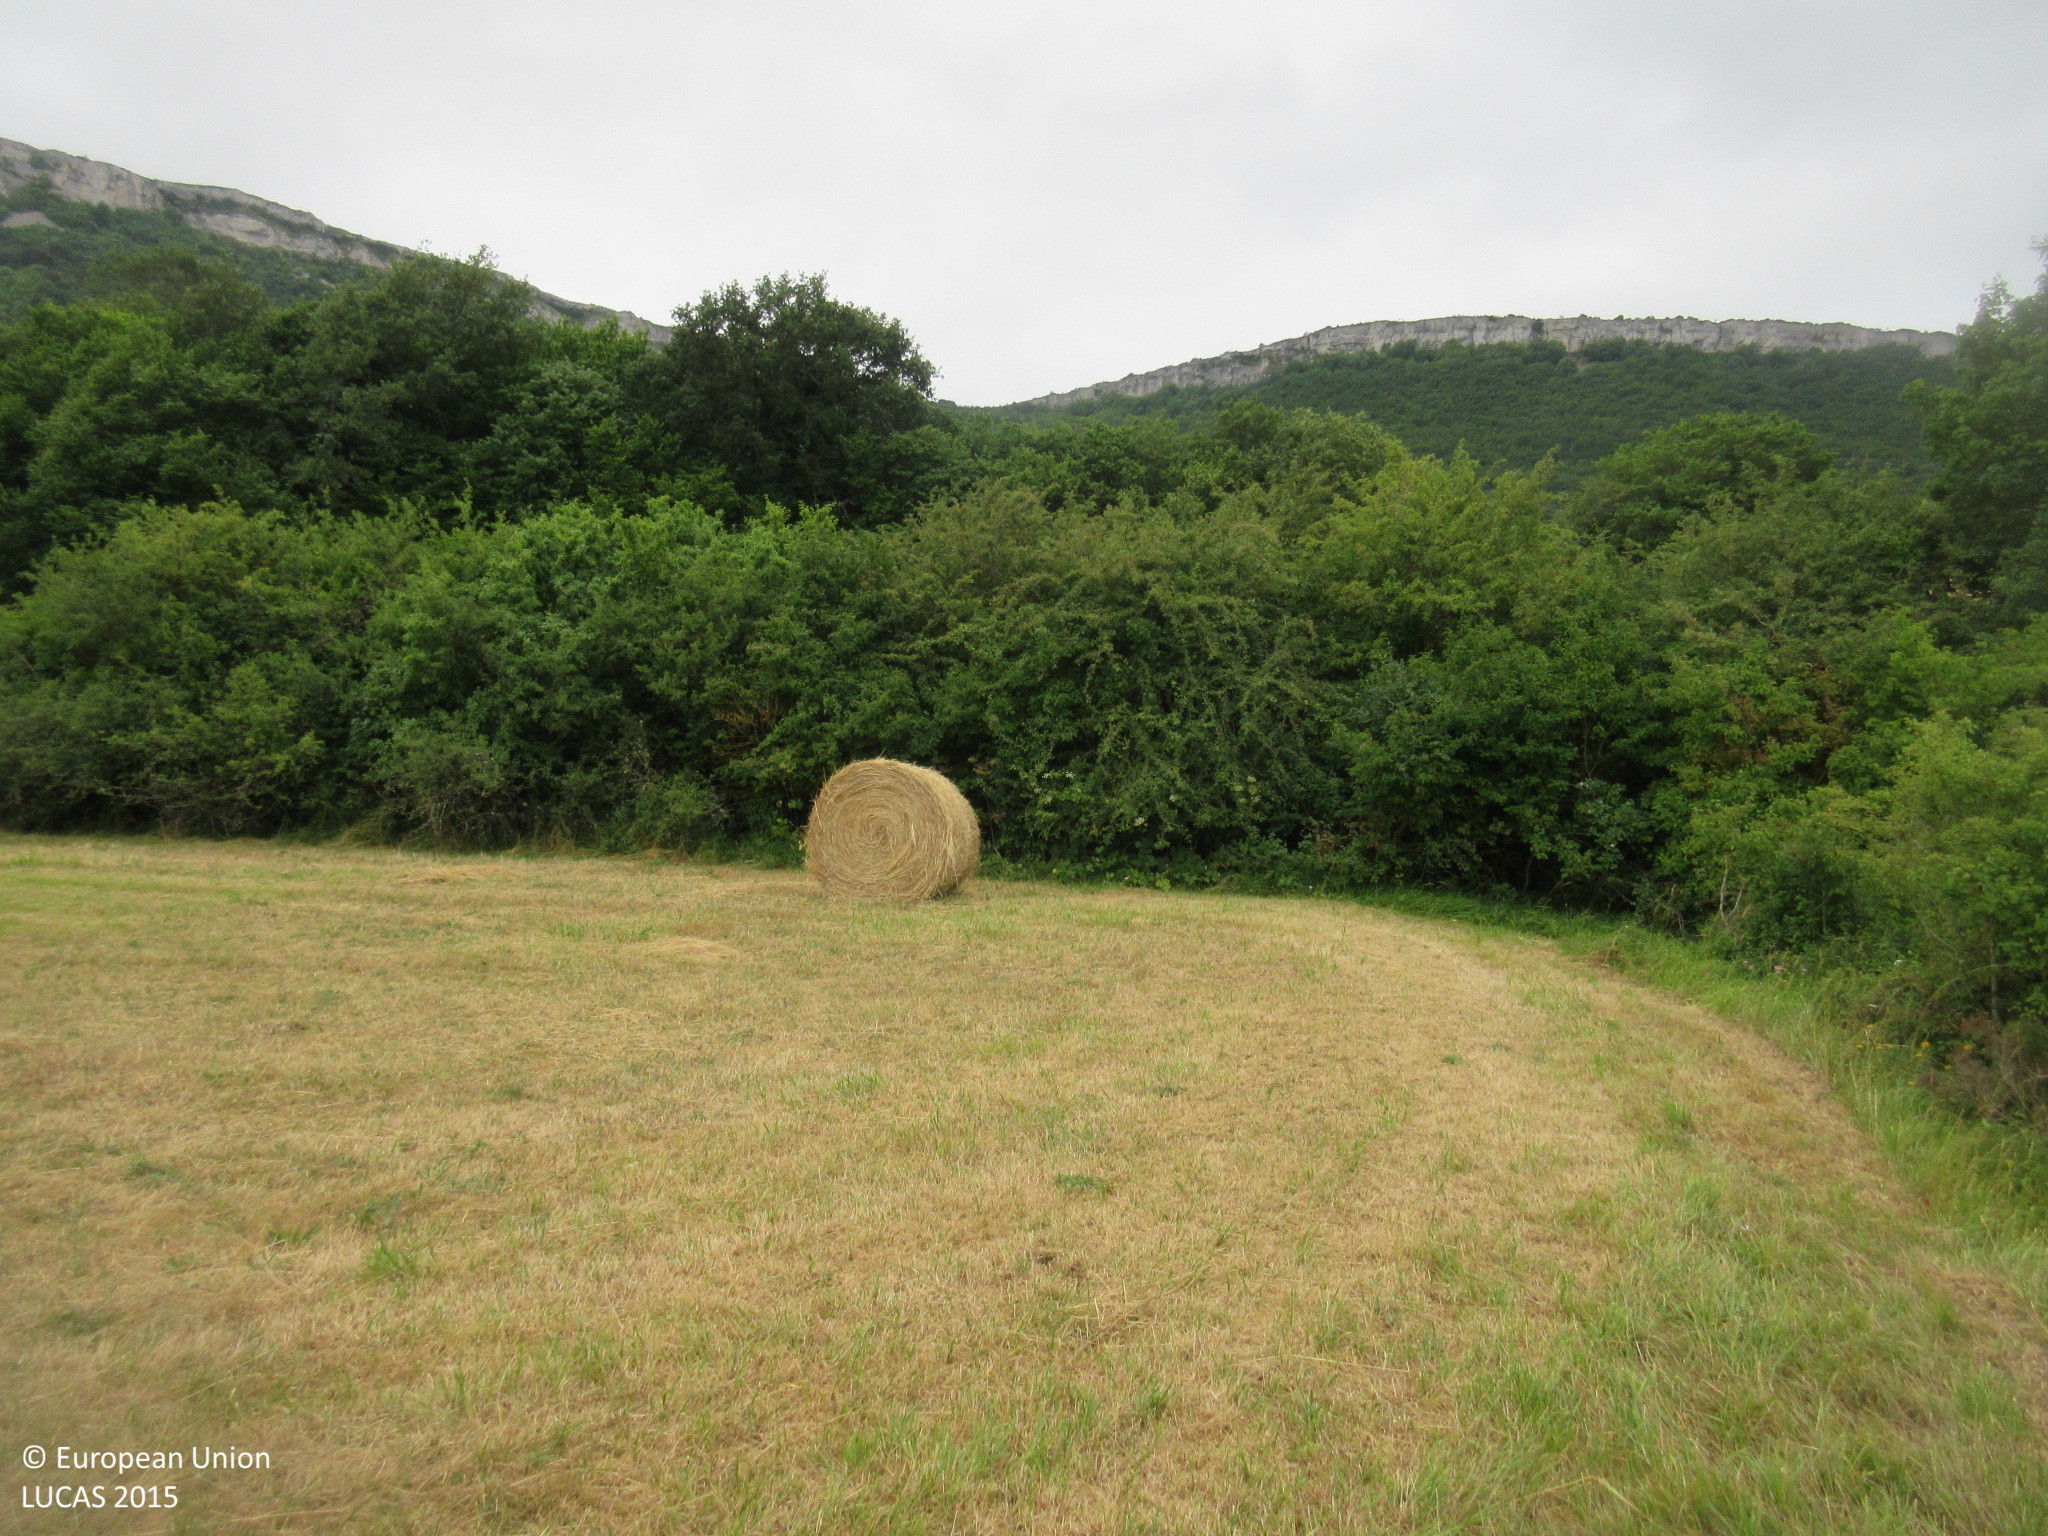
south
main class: Grassland
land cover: Grassland without tree/shrub cover
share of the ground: > 75 %
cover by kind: herbaceous plants 100 %
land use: Agriculture (excluding fallow land and kitchen gardens)
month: July
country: ES
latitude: 43.0539
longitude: -3.5588
